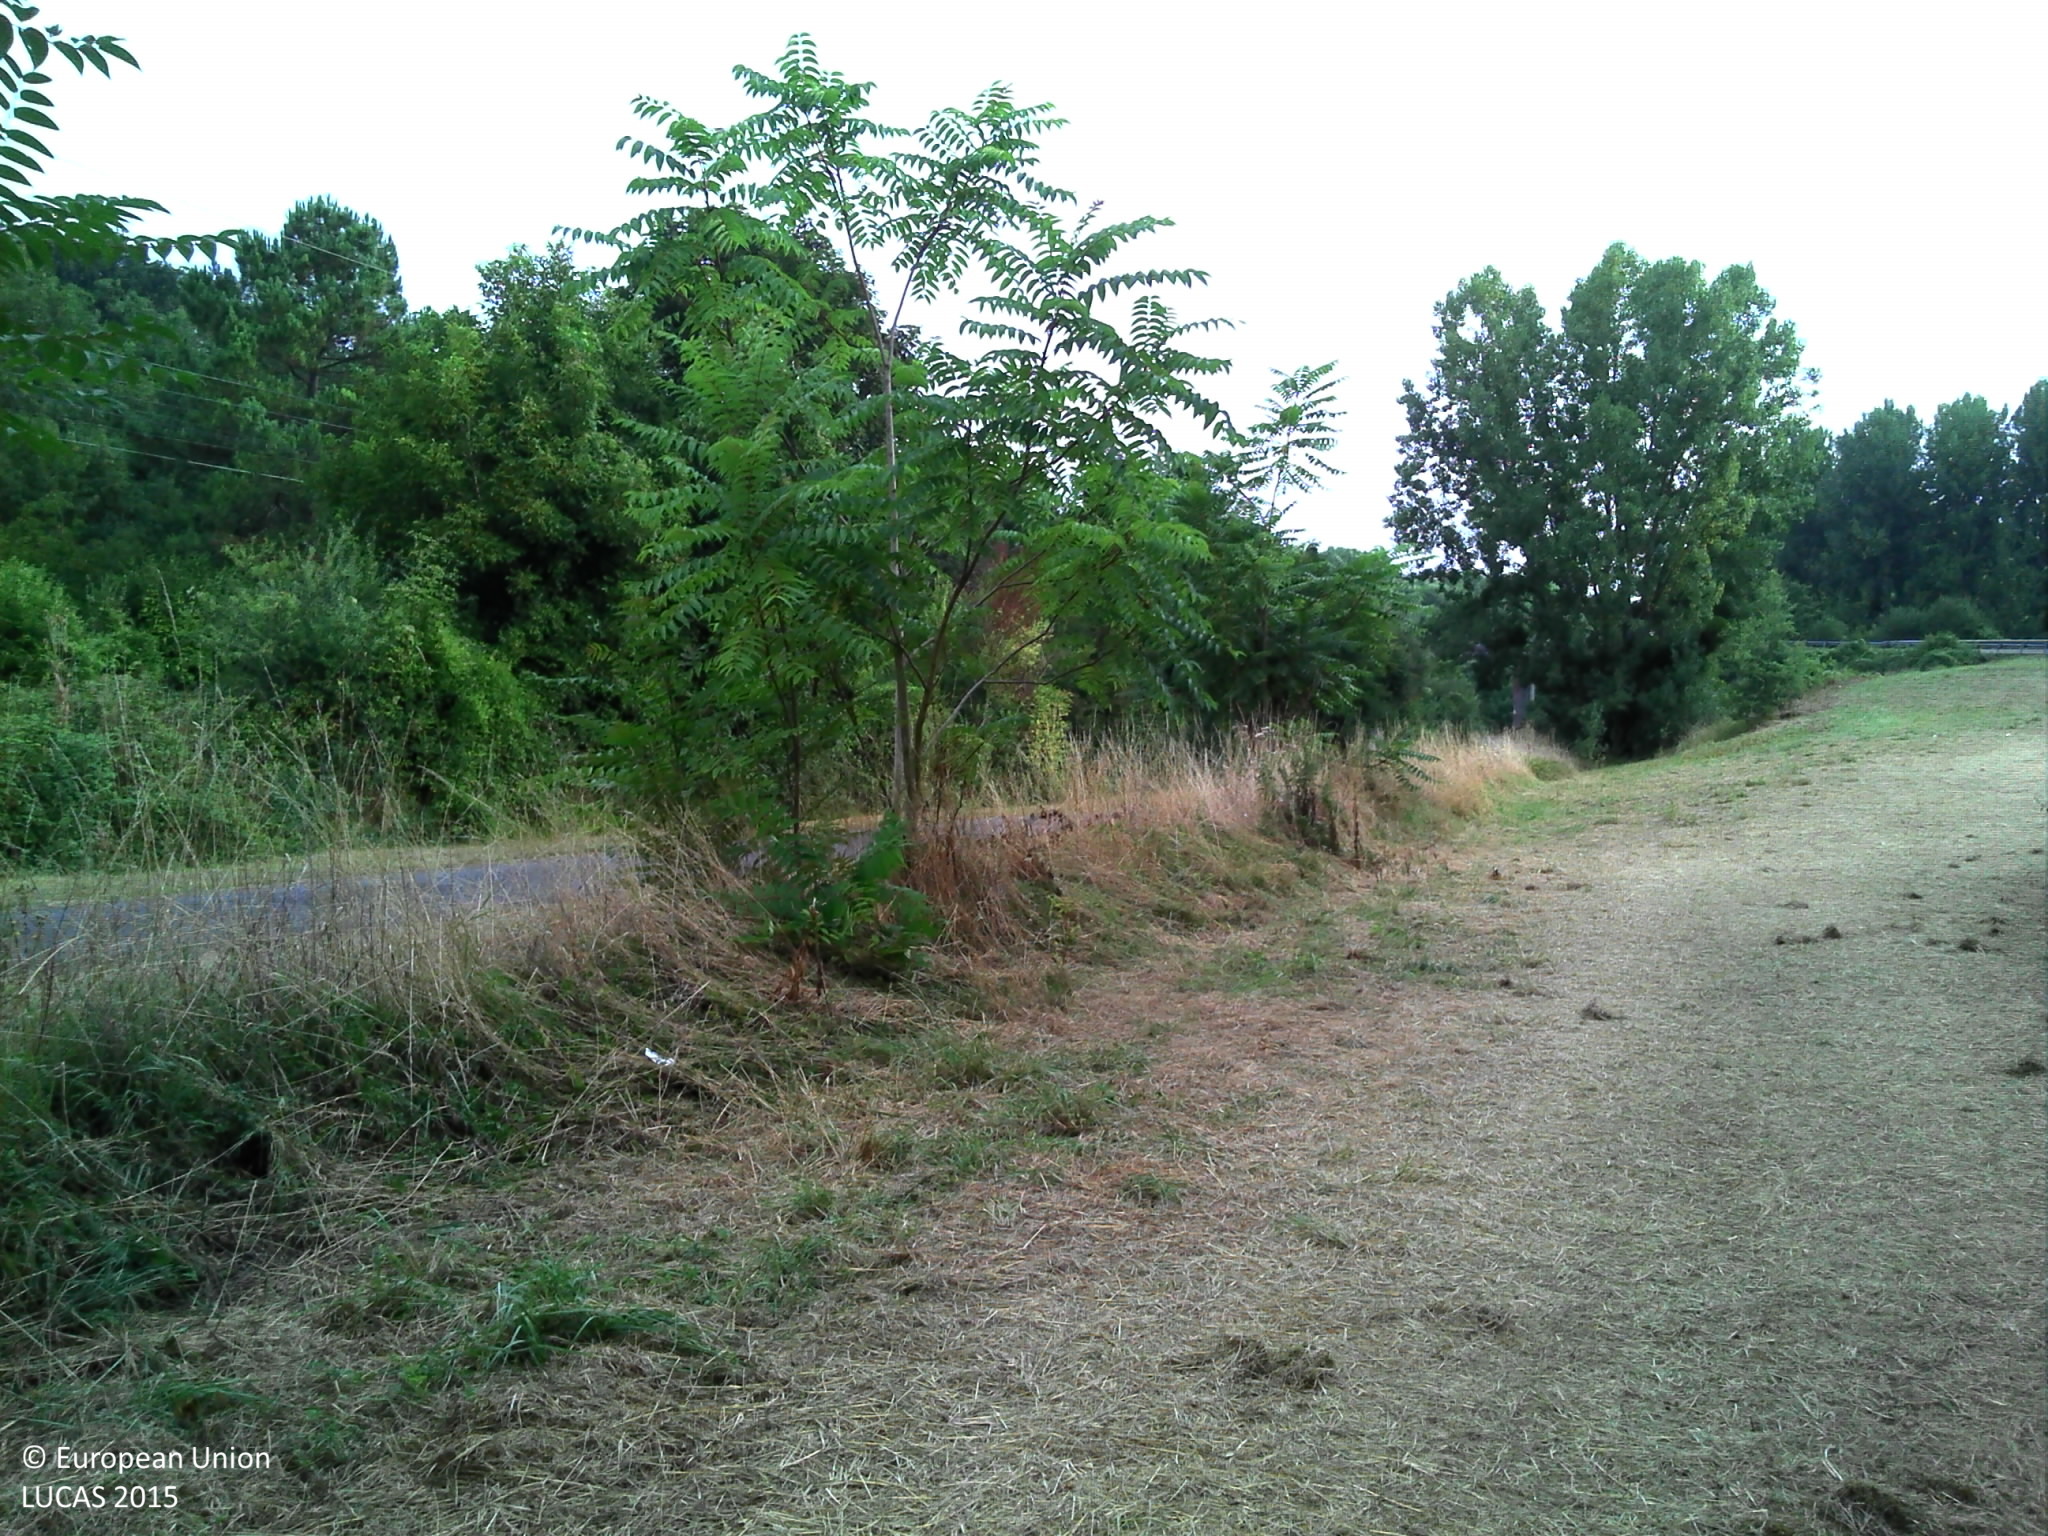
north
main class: Grassland
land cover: Grassland without tree/shrub cover
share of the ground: > 75 %
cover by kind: herbaceous plants 100 %
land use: Agriculture (excluding fallow land and kitchen gardens)
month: August
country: FR
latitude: 46.4720
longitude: 0.3046
